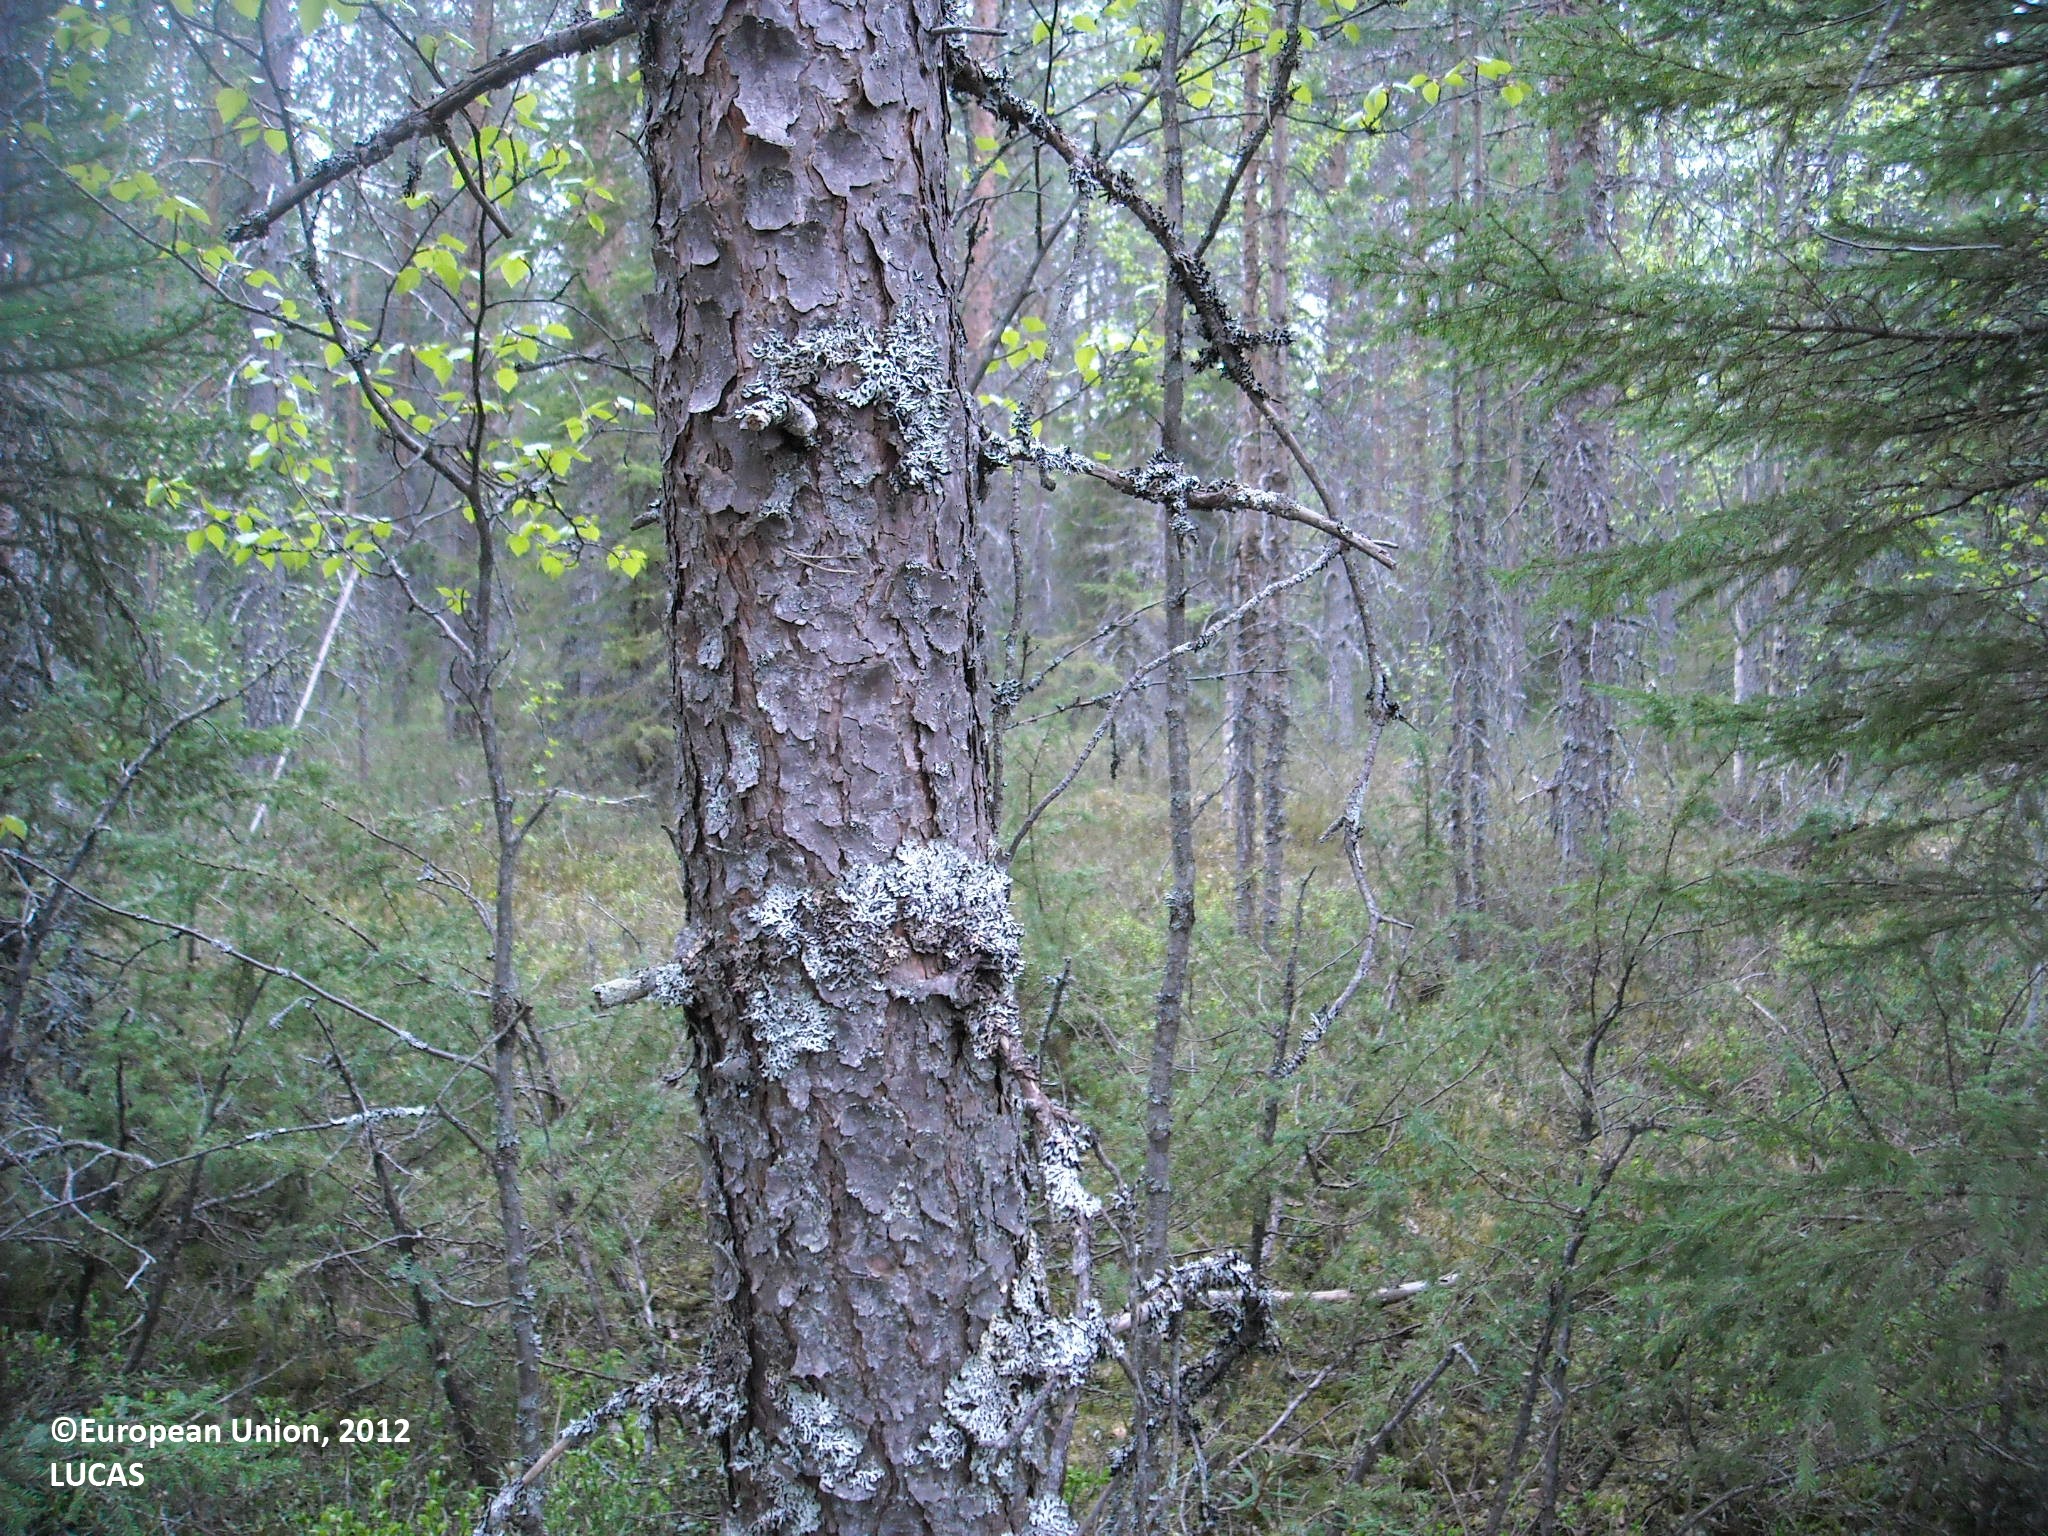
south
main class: Woodland
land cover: Pine dominated coniferous woodland
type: boreal forest
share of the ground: > 75 %
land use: Forestry
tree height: > 5 m
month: June
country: FI
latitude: 64.6517
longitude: 27.4094
